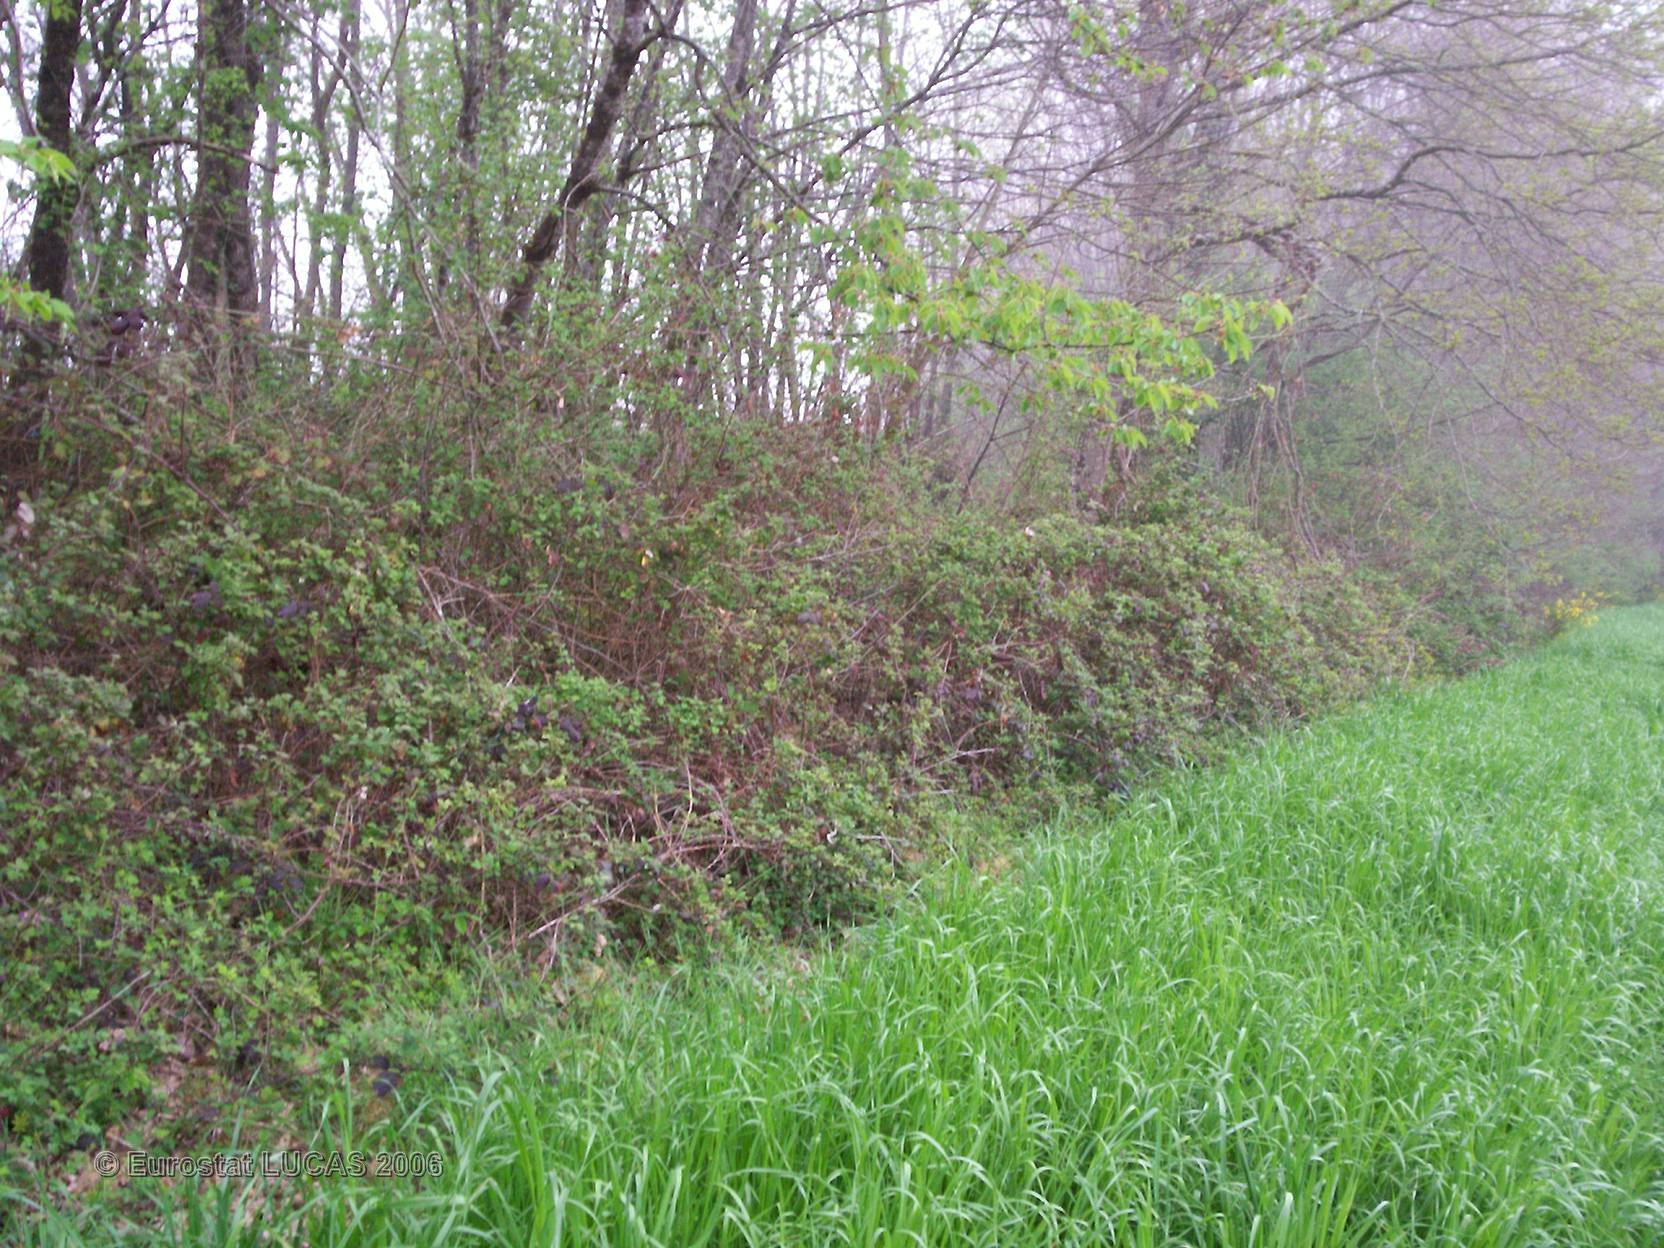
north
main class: Grassland
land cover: Grassland without tree/shrub cover
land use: Agriculture (excluding fallow land and kitchen gardens)
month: April
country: FR
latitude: 45.4639
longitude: 0.5876
